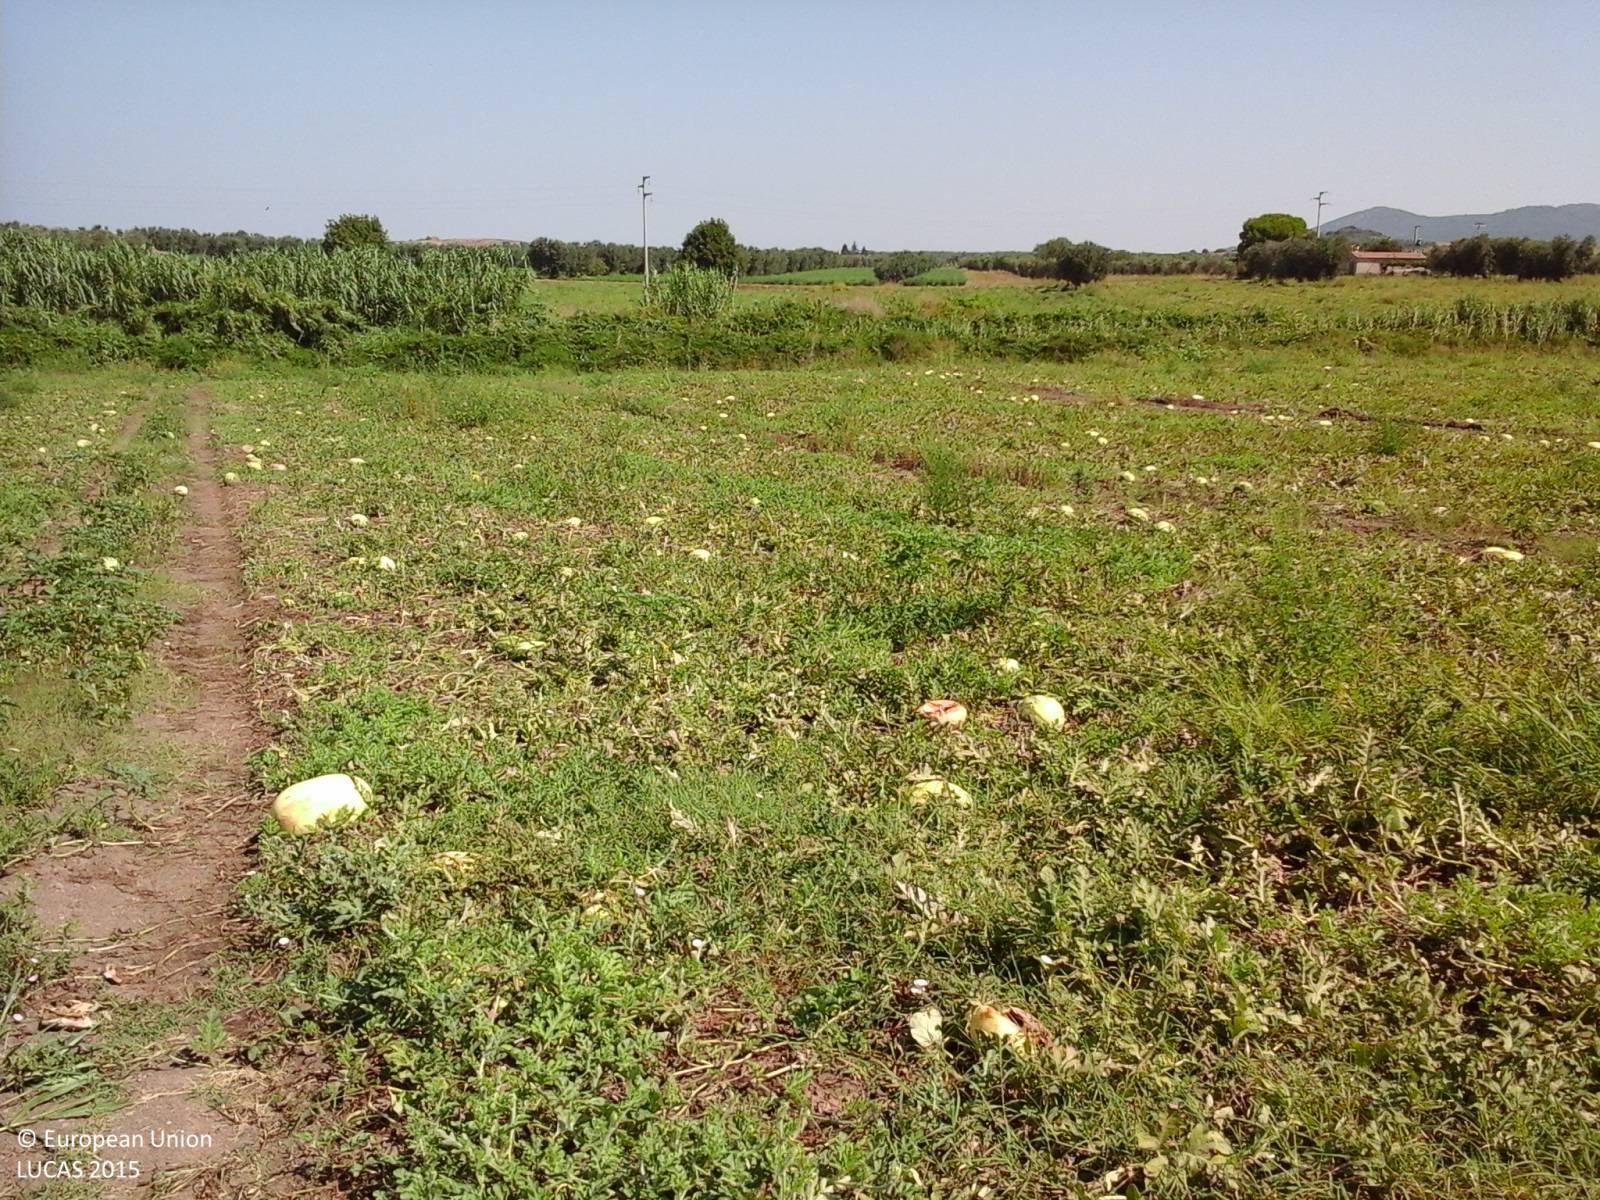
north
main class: Cropland
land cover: Other fresh vegetables
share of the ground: > 75 %
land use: Agriculture (excluding fallow land and kitchen gardens)
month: August
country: IT
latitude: 42.4056
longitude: 11.6588
